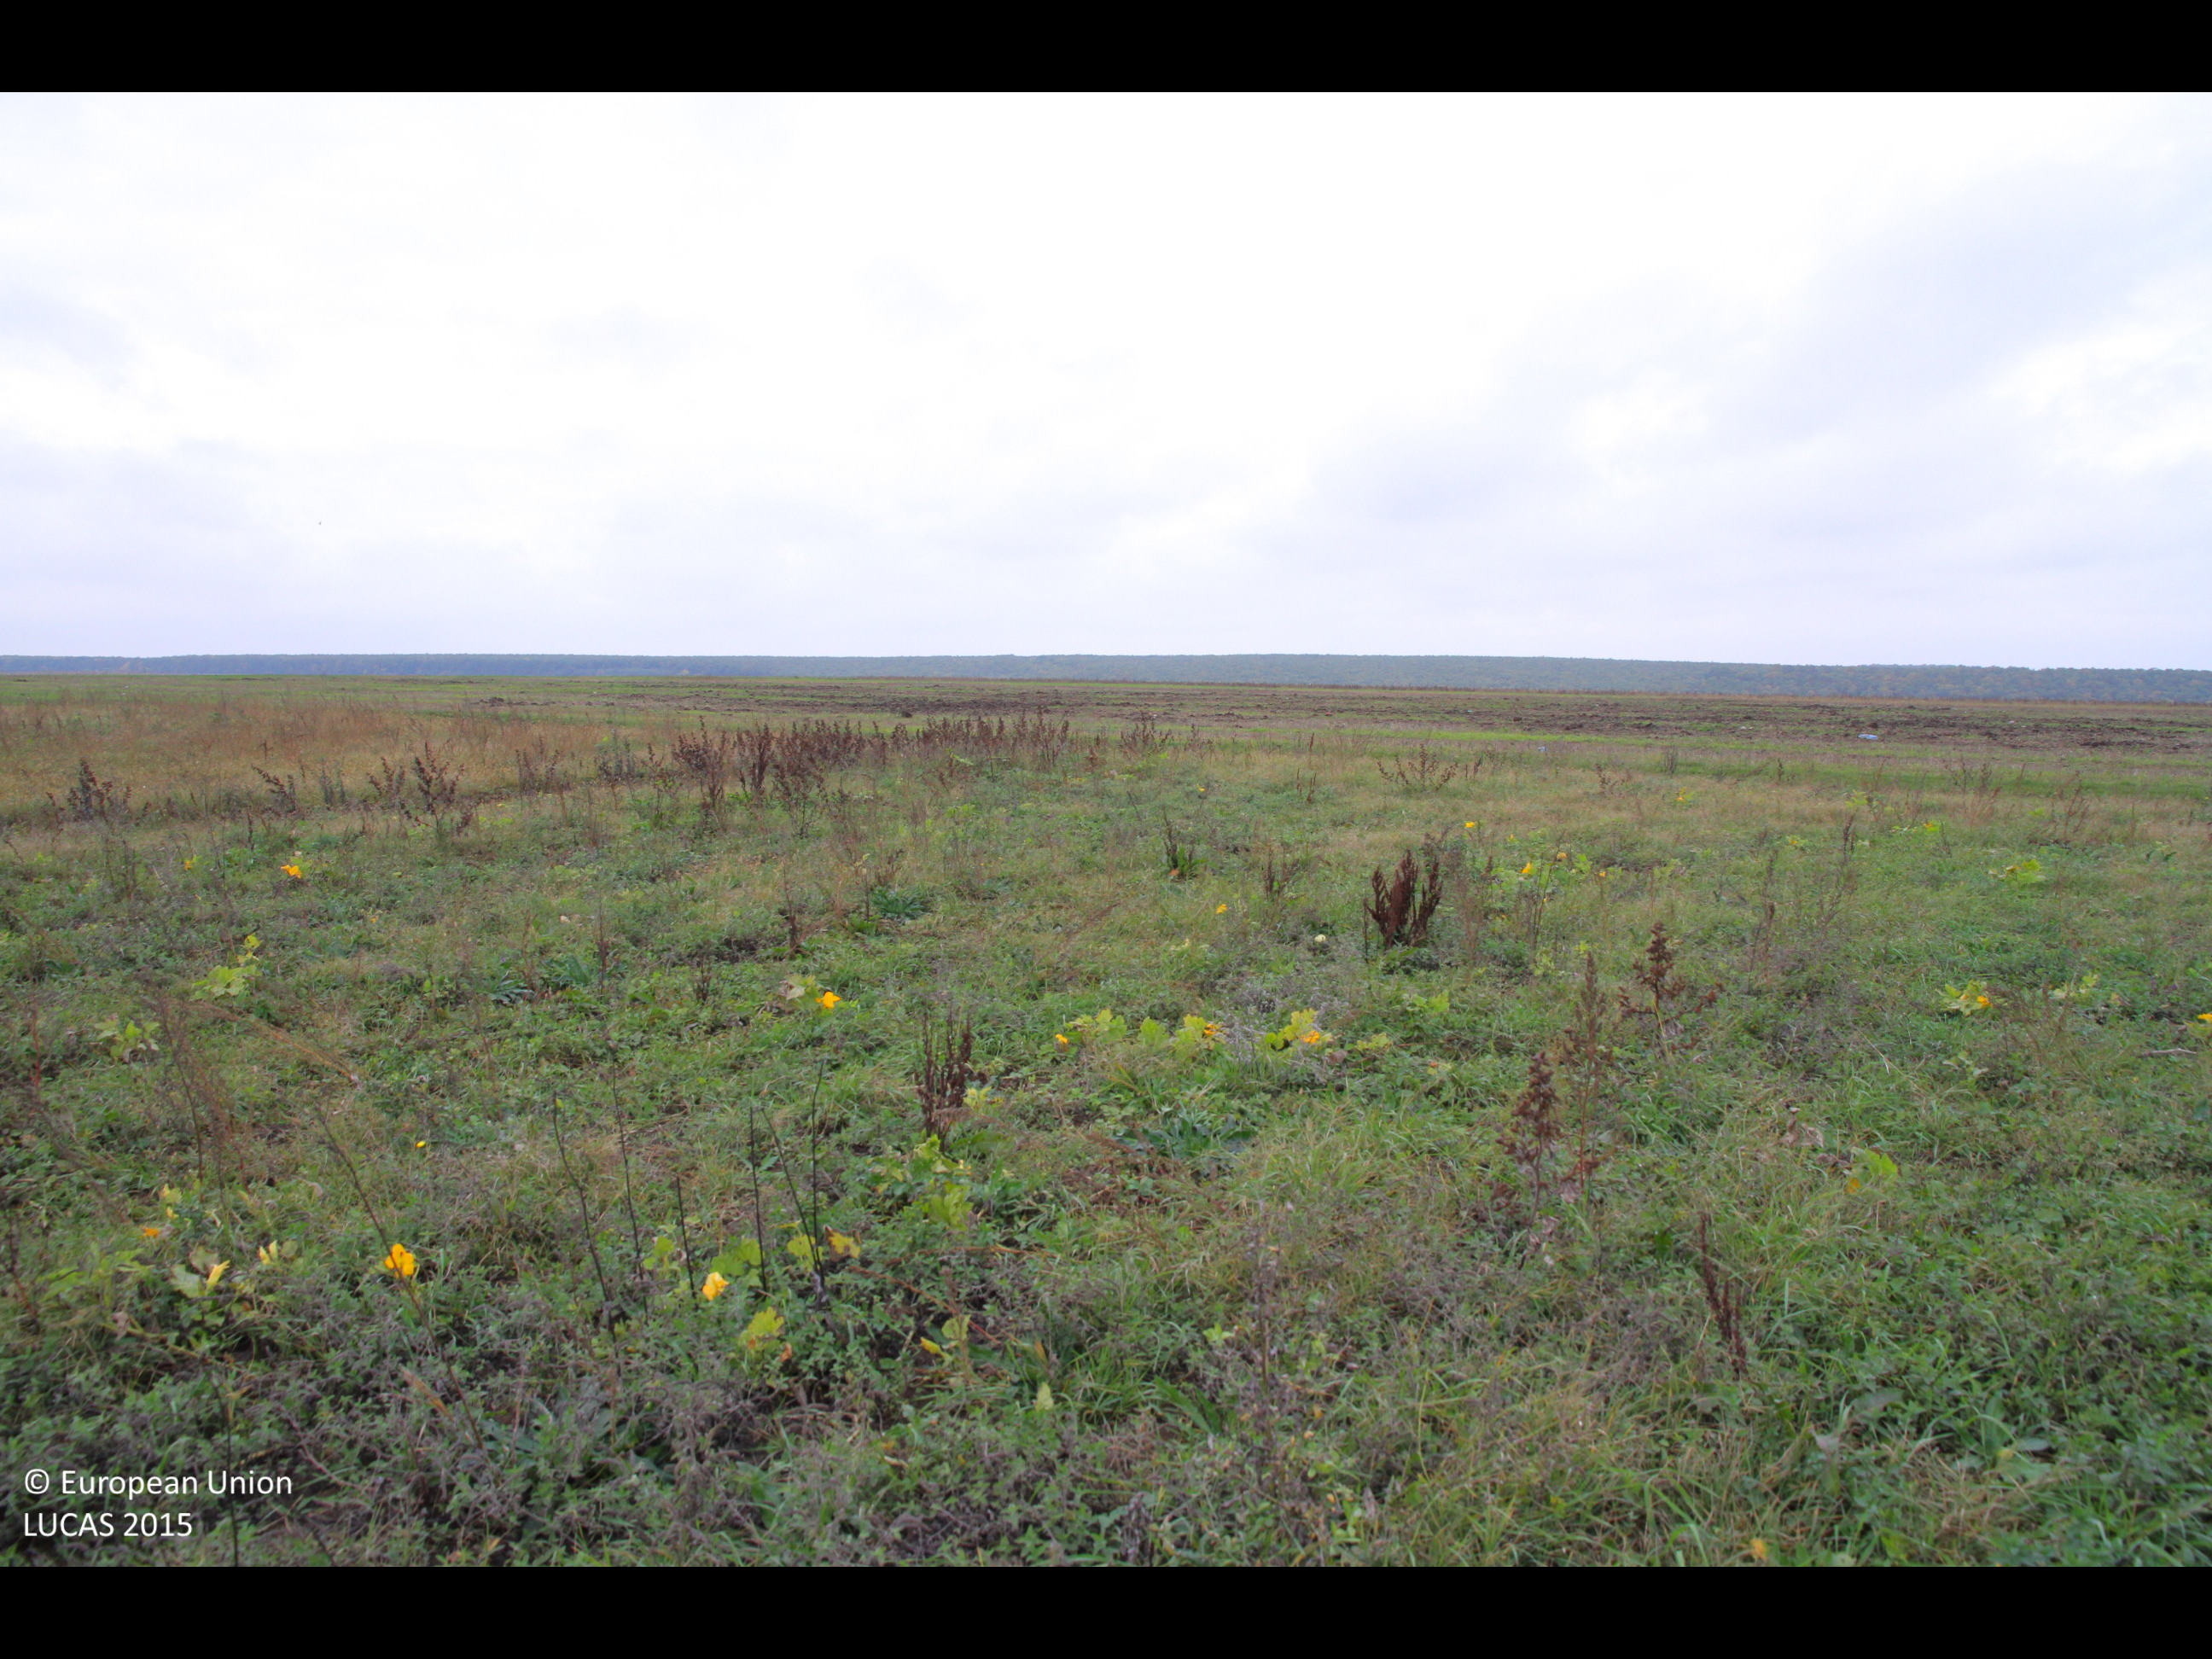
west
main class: Cropland
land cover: Other fresh vegetables
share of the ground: 10 - 25 %
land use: Agriculture (excluding fallow land and kitchen gardens)
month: October
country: BG
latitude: 43.5434
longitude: 26.8849
